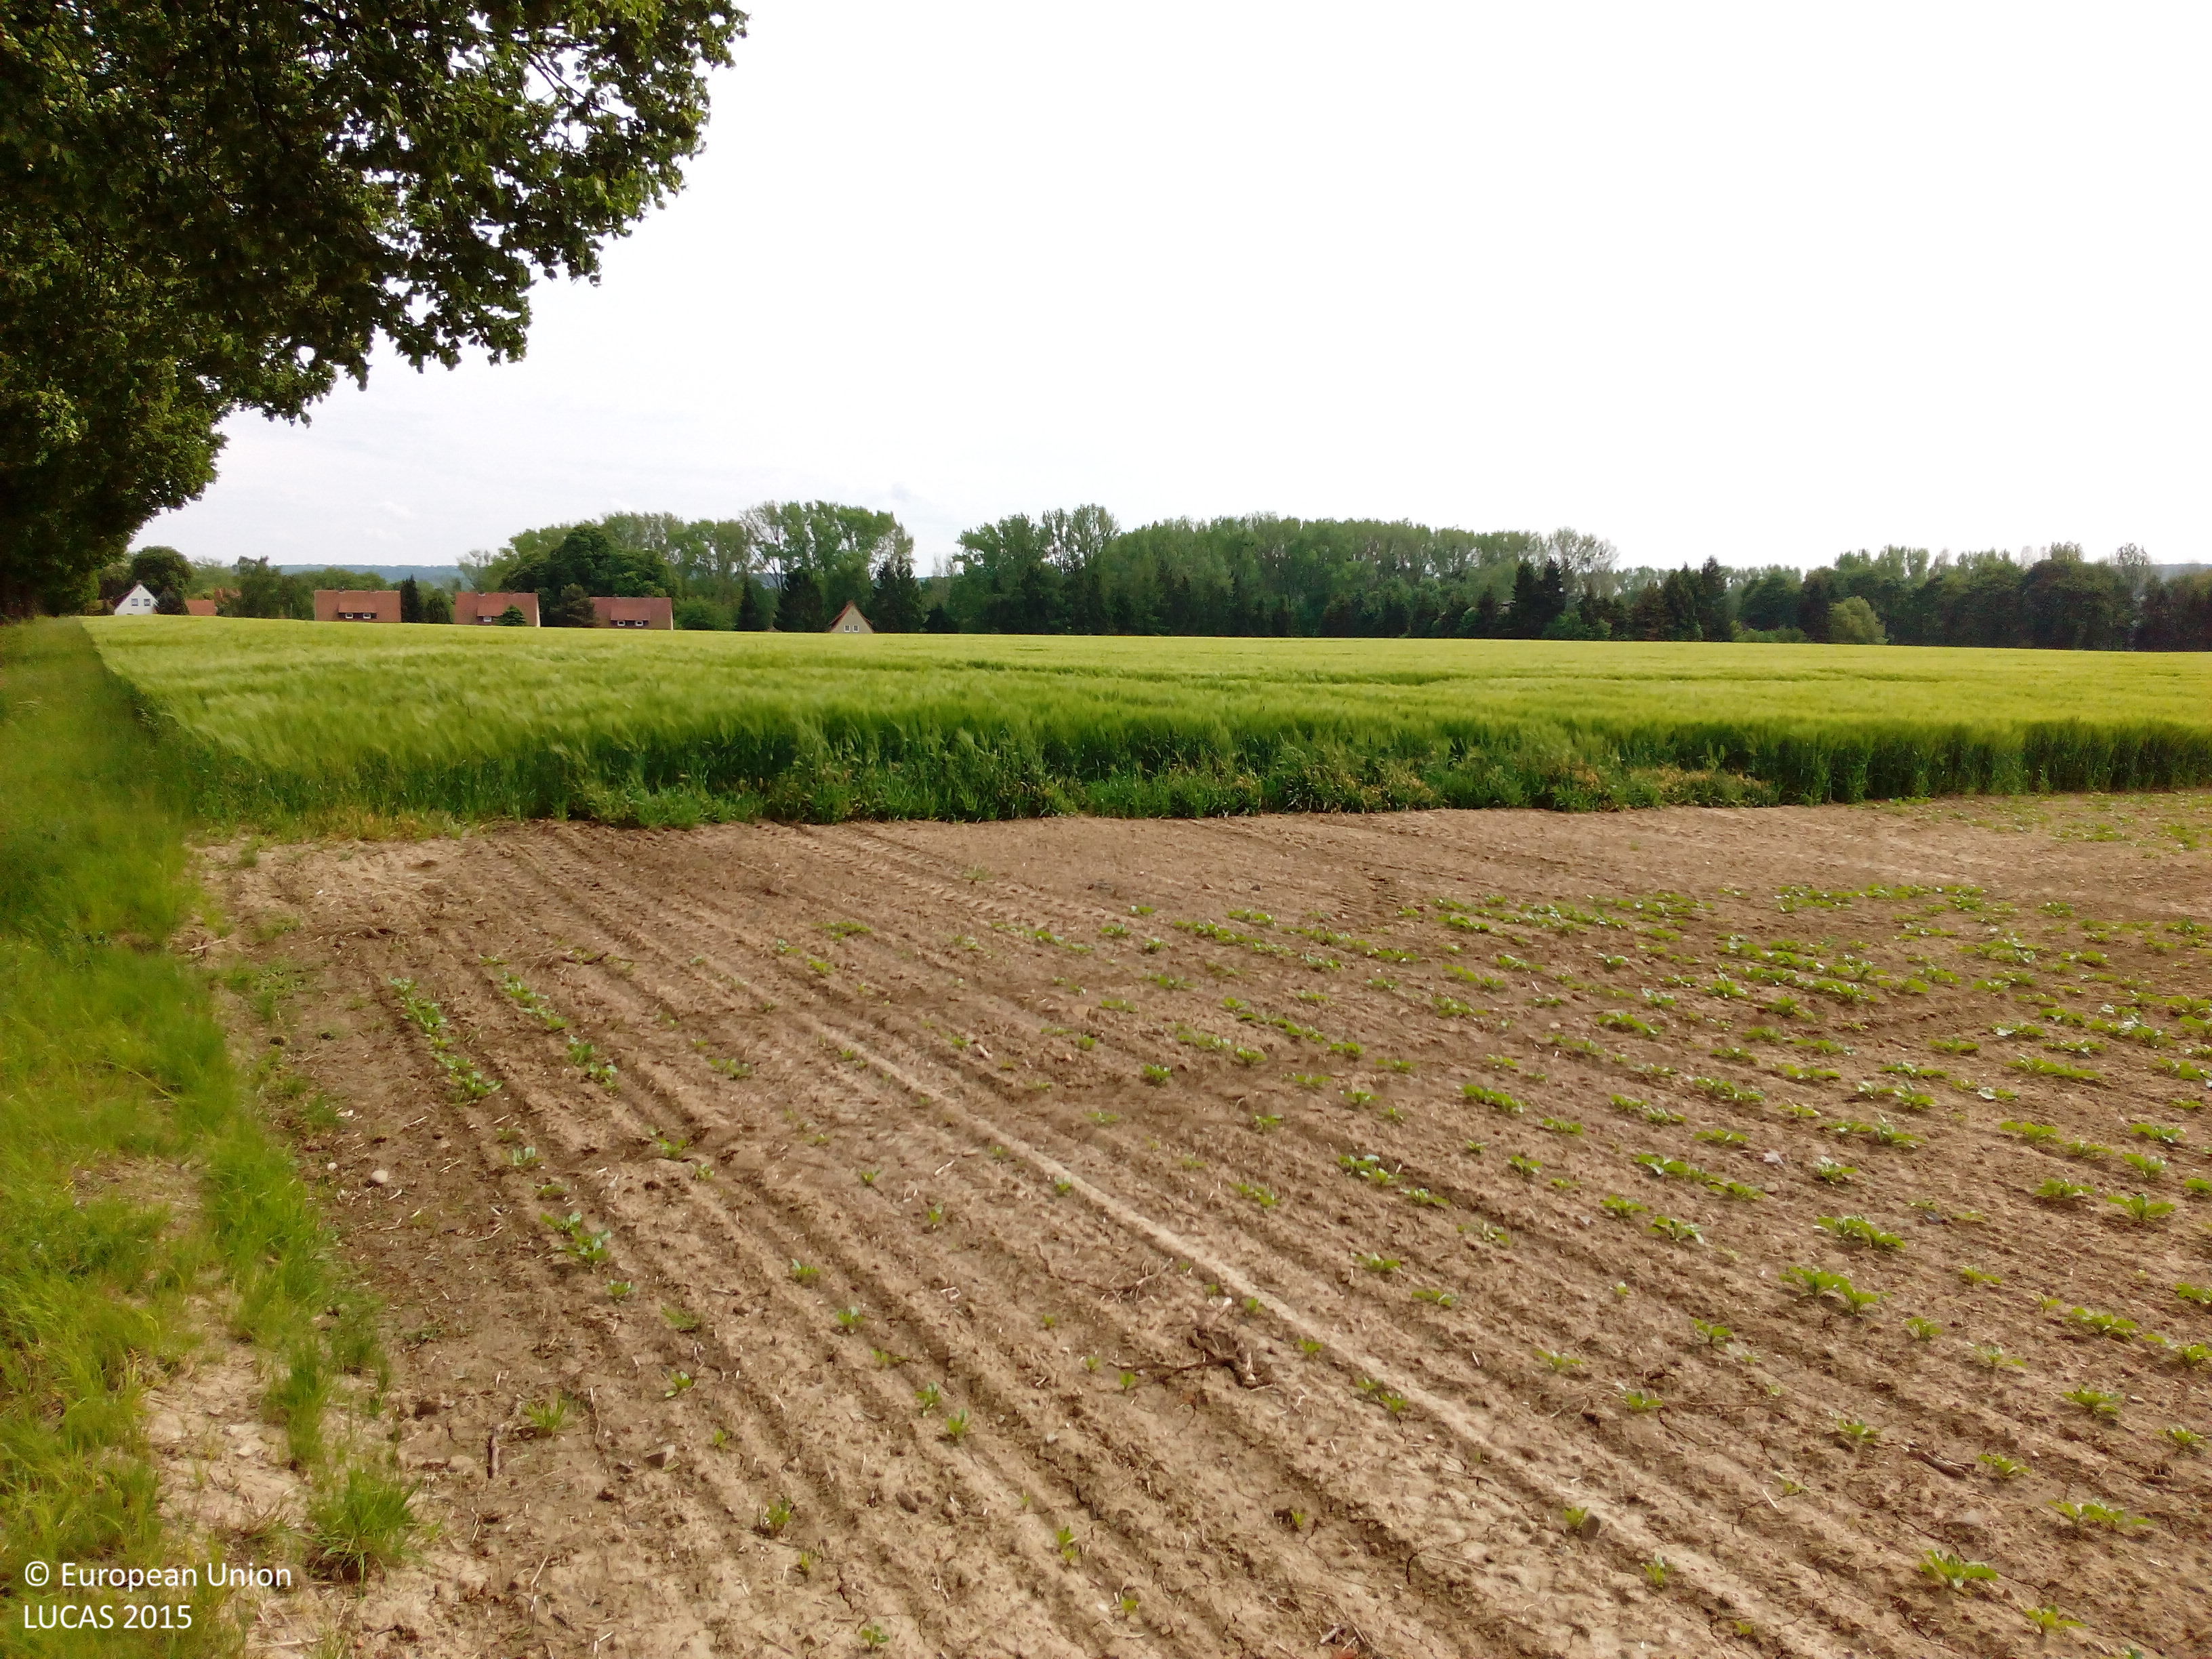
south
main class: Cropland
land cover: Sugar beet
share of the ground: 25 - 50 %
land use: Agriculture (excluding fallow land and kitchen gardens)
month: May
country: DE
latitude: 52.0536
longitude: 10.2770
